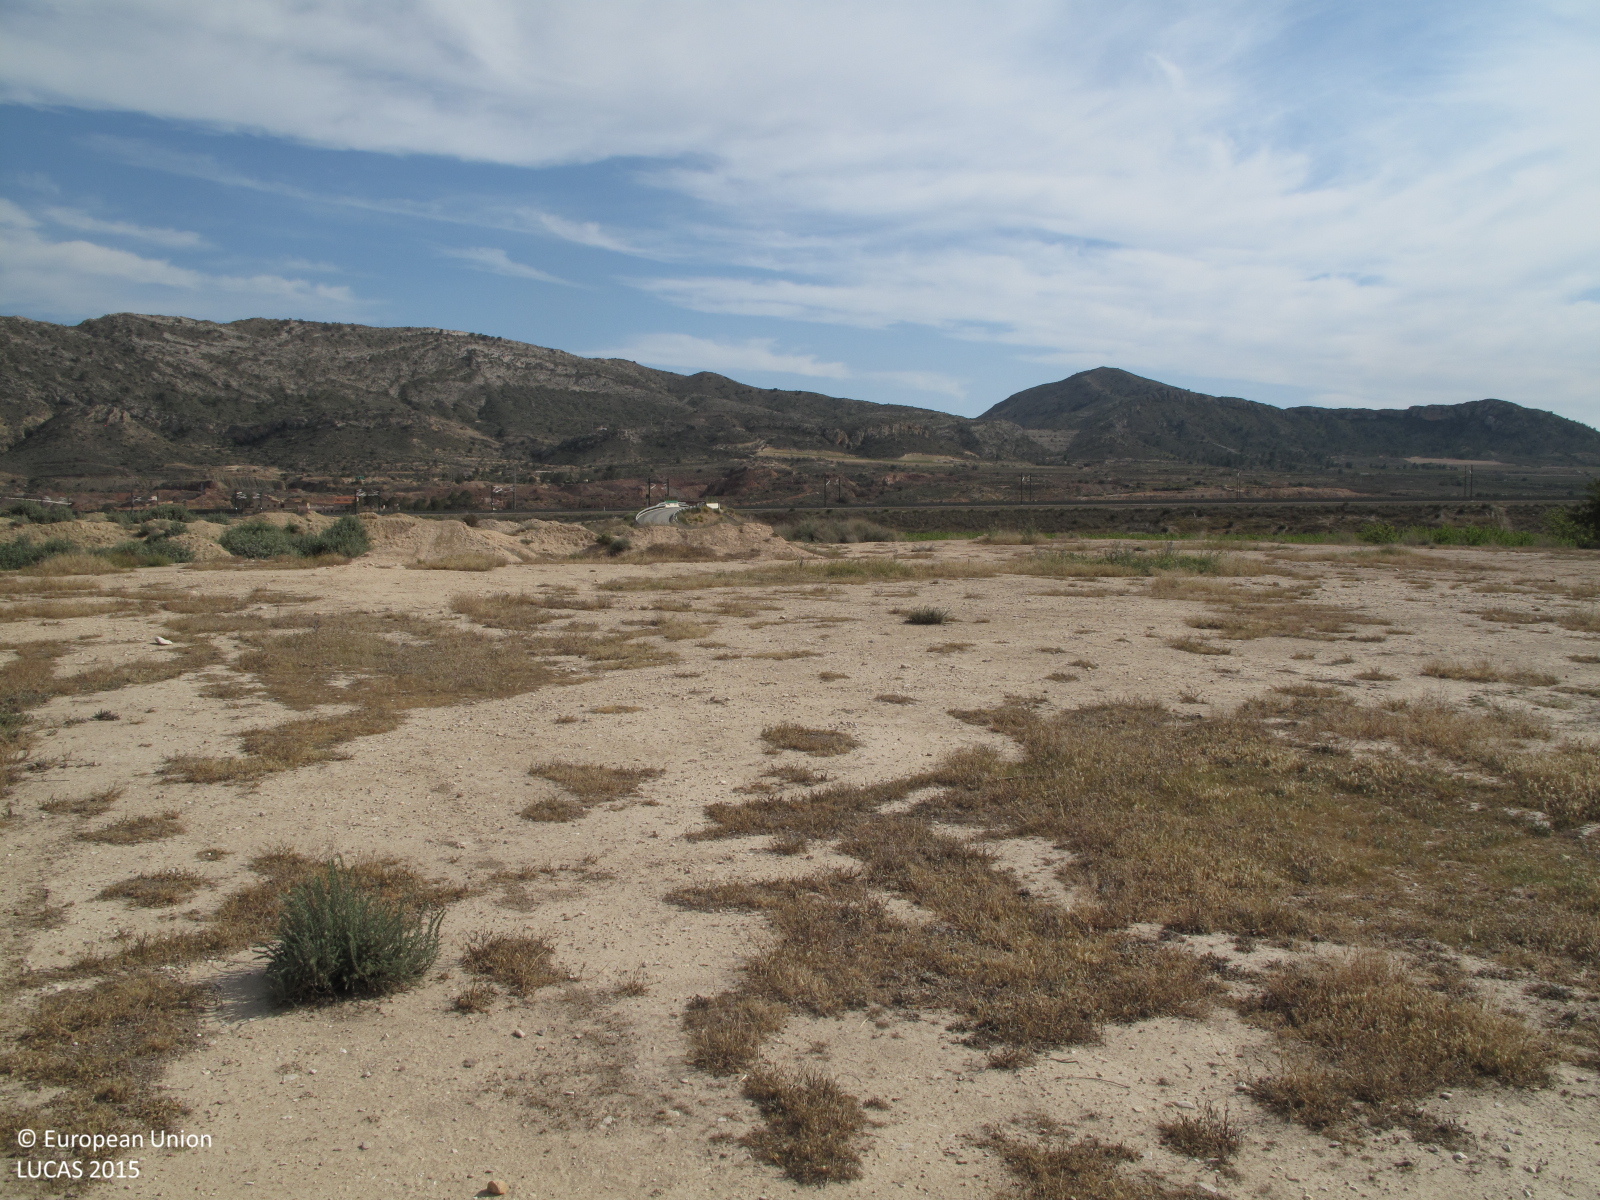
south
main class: Grassland
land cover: Grassland without tree/shrub cover
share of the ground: 10 - 25 %
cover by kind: consolidated bare surface 80 %, herbaceous plants 20 %
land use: Semi-natural and natural areas not in use
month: April
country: ES
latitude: 38.4087
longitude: -0.6485
